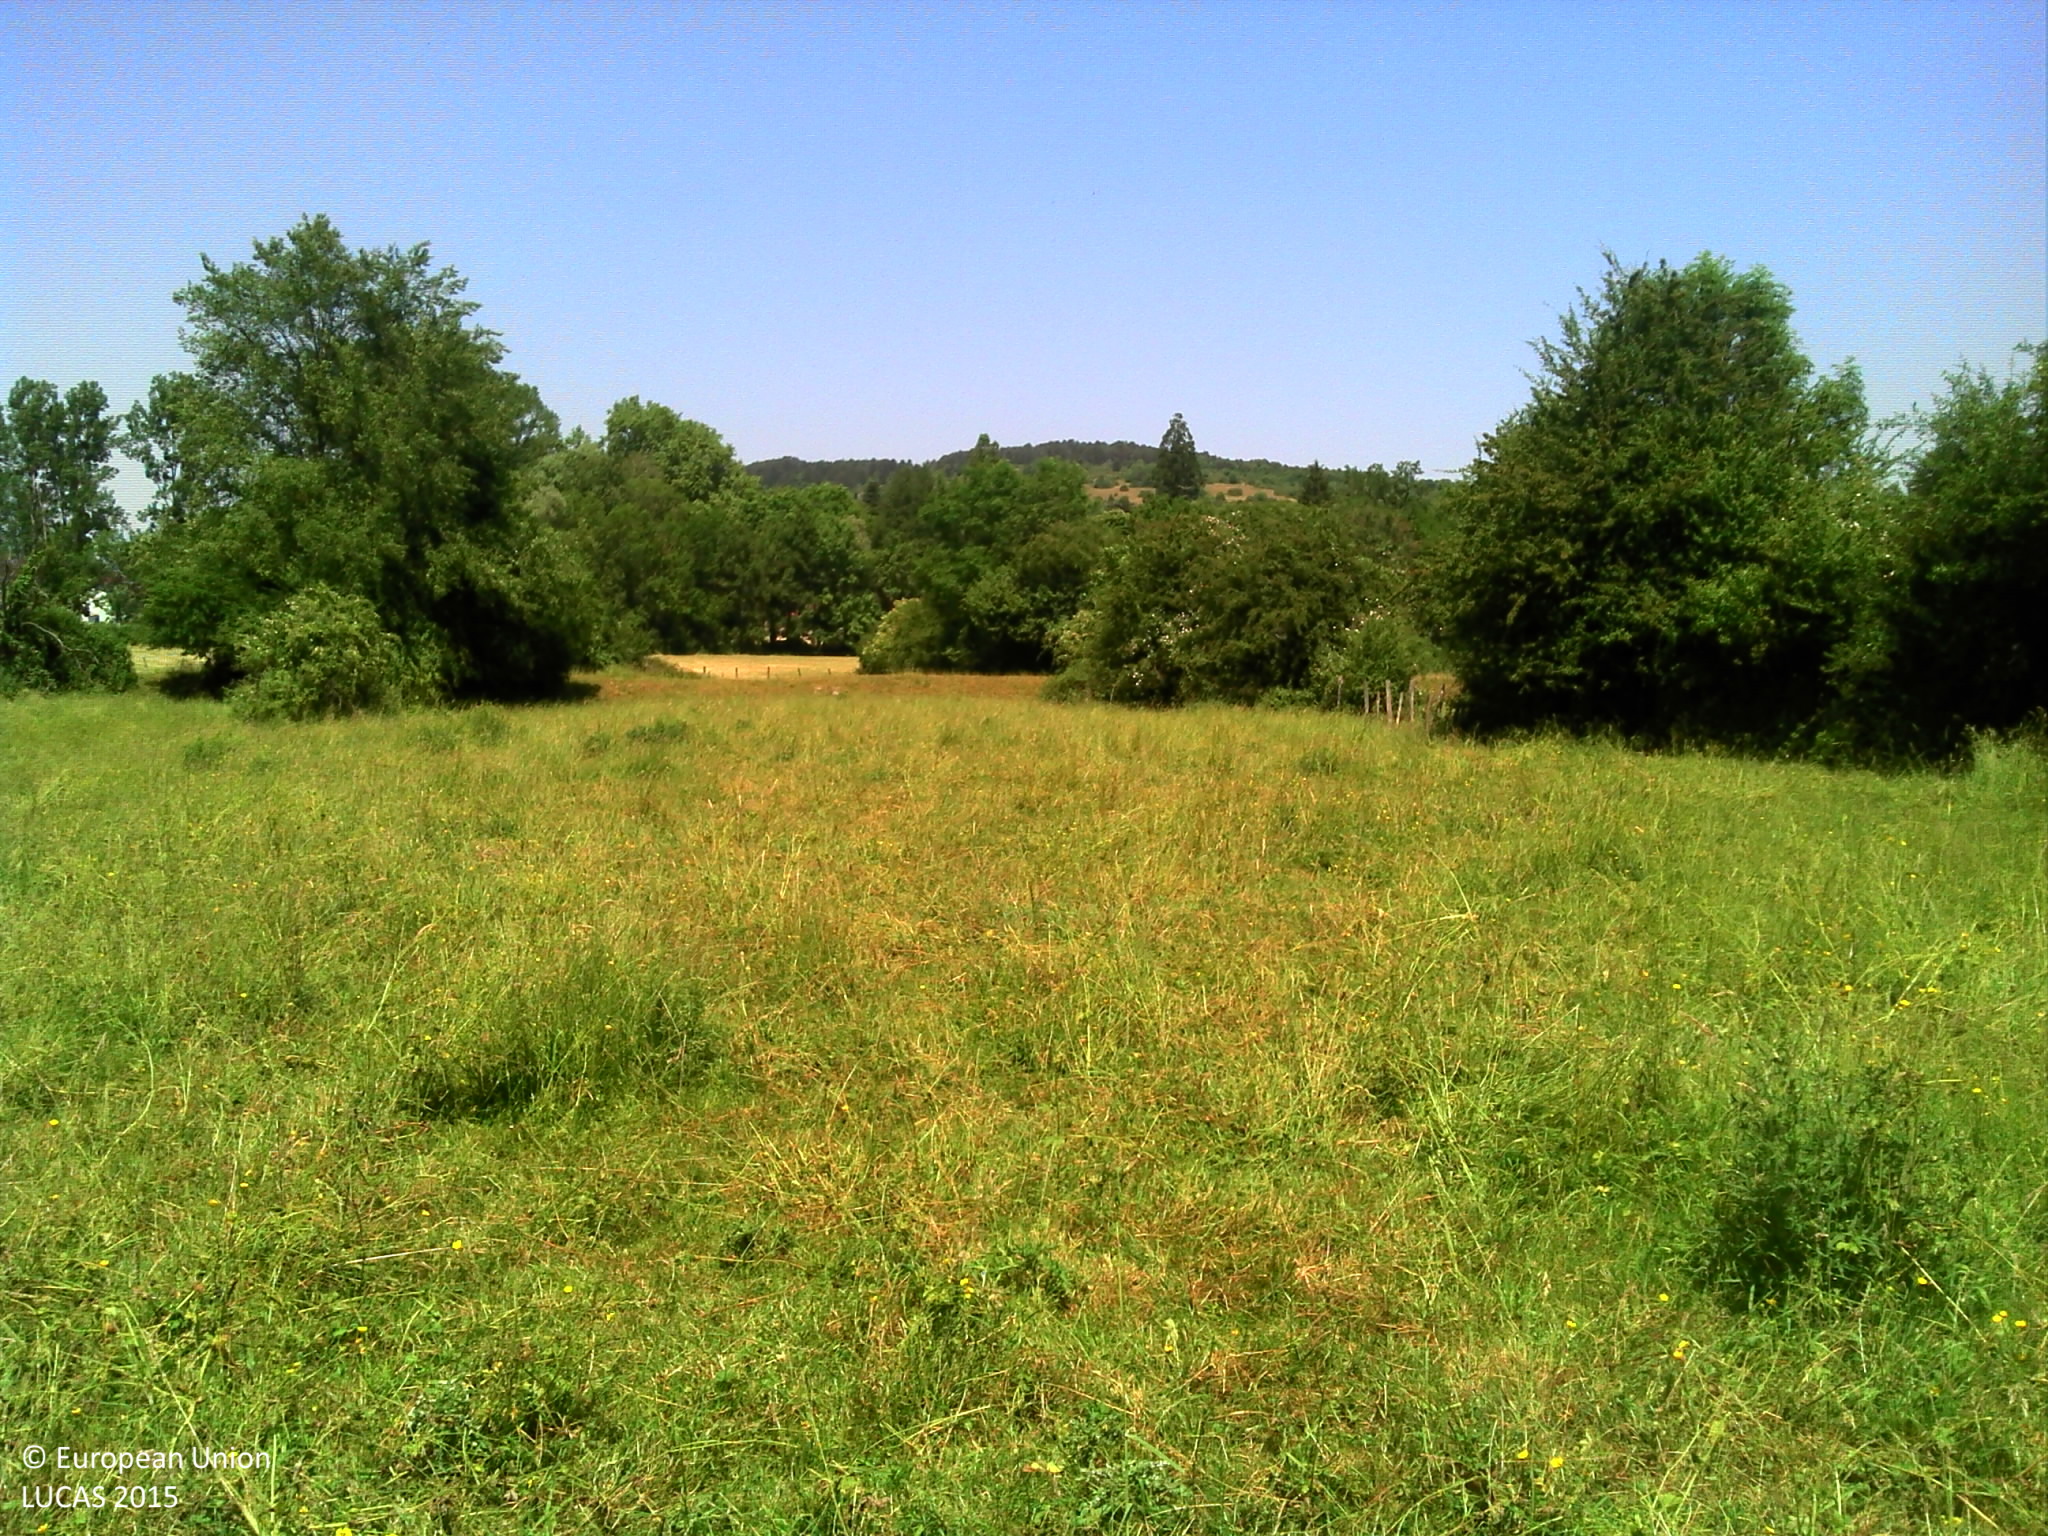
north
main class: Grassland
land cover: Grassland without tree/shrub cover
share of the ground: > 75 %
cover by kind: herbaceous plants 100 %
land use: Agriculture (excluding fallow land and kitchen gardens)
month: June
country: FR
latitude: 47.6170
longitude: 6.1828
